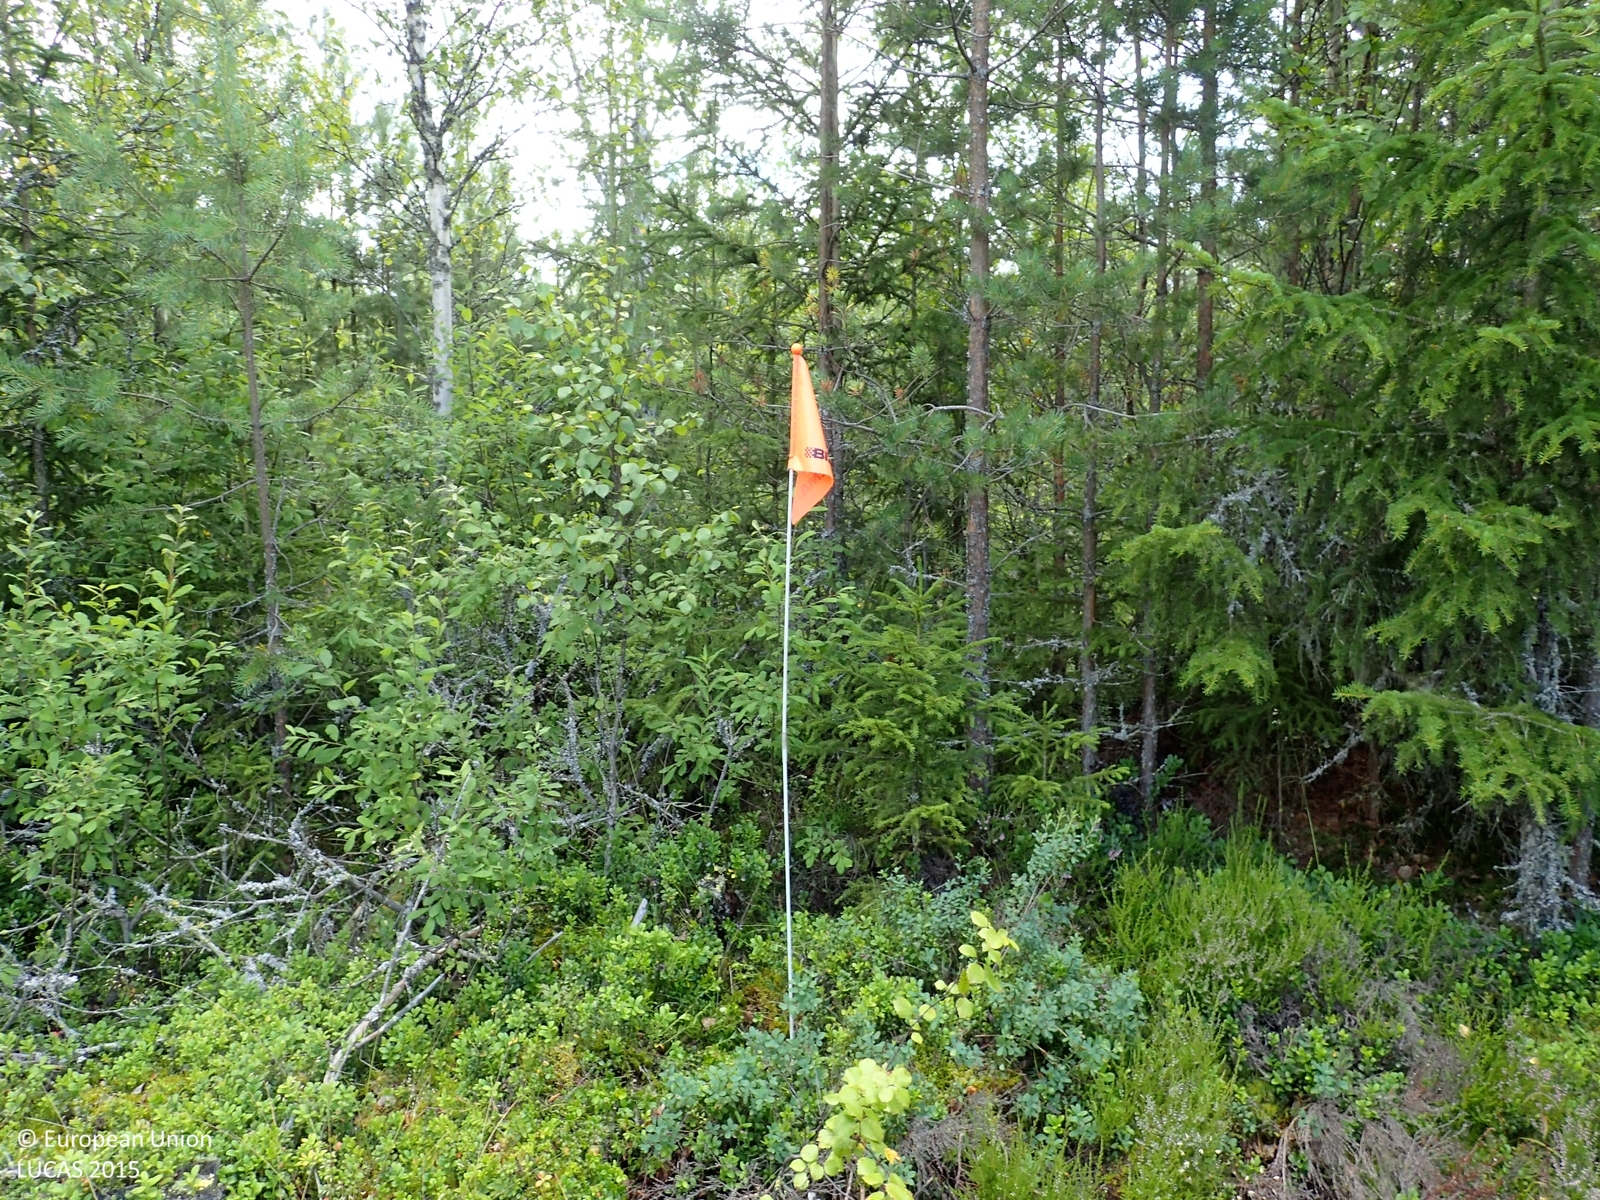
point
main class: Woodland
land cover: Pine dominated mixed woodland
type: boreal forest
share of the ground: 50 - 75 %
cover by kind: shrubs 45 %, broadleaved forest trees 30 %, coniferous forest trees 25 %
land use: Forestry
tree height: < 5 m
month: August
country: FI
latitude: 62.6247
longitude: 21.7612
